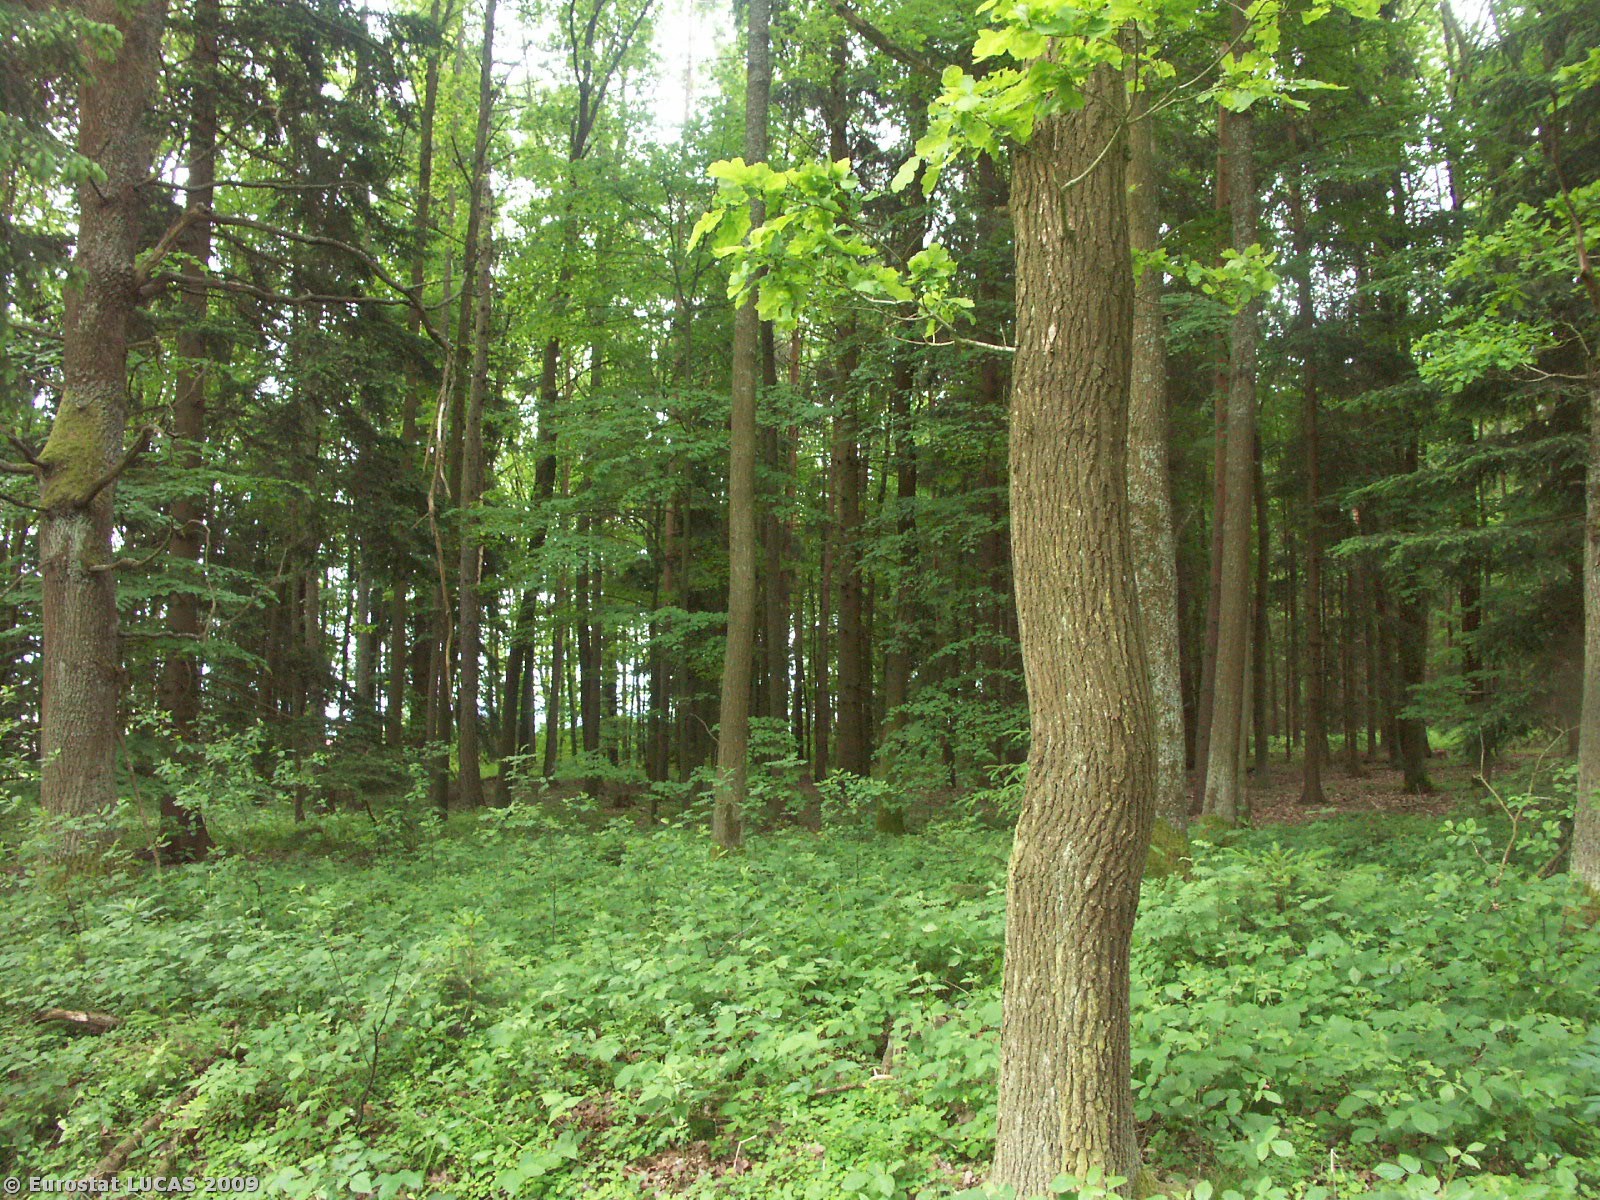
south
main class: Woodland
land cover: Mixed woodland
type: hemiboreal forest and nemoral coniferous forest and mixed broadleaved-coniferous forest
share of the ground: > 75 %
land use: Forestry
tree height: > 5 m
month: May
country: CZ
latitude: 48.8644
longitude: 14.6497
